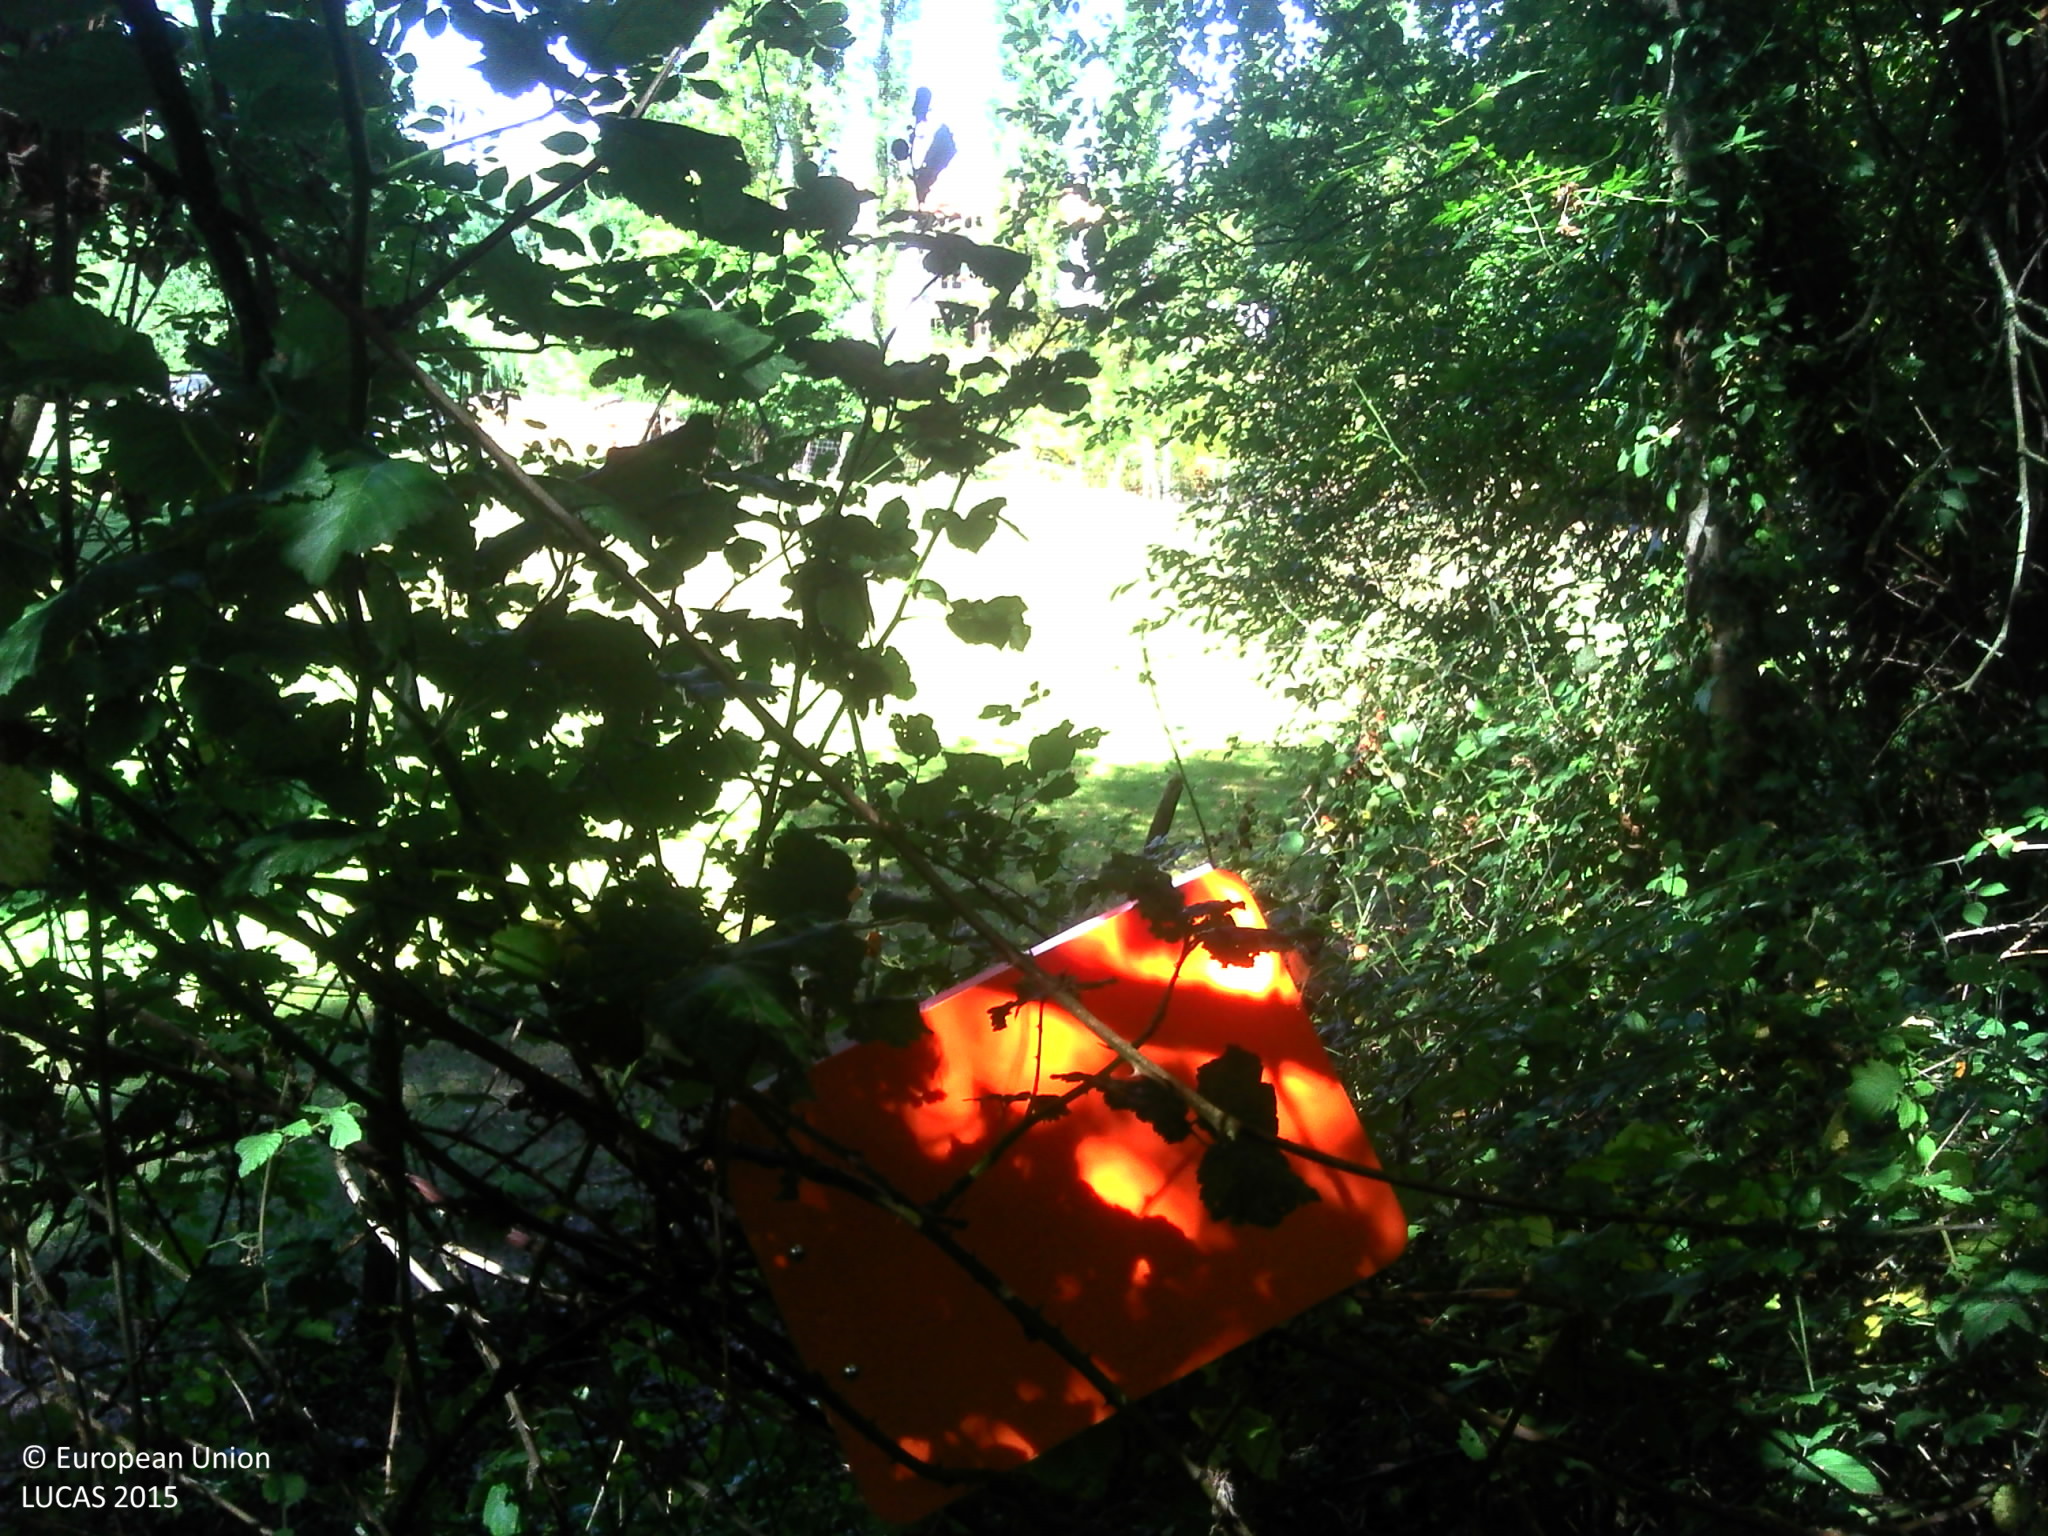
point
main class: Woodland
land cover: Broadleaved woodland
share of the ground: > 75 %
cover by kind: broadleaved forest trees 95 %, shrubs 5 %
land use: Road transport
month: August
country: FR
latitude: 46.7338
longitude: -1.6220
